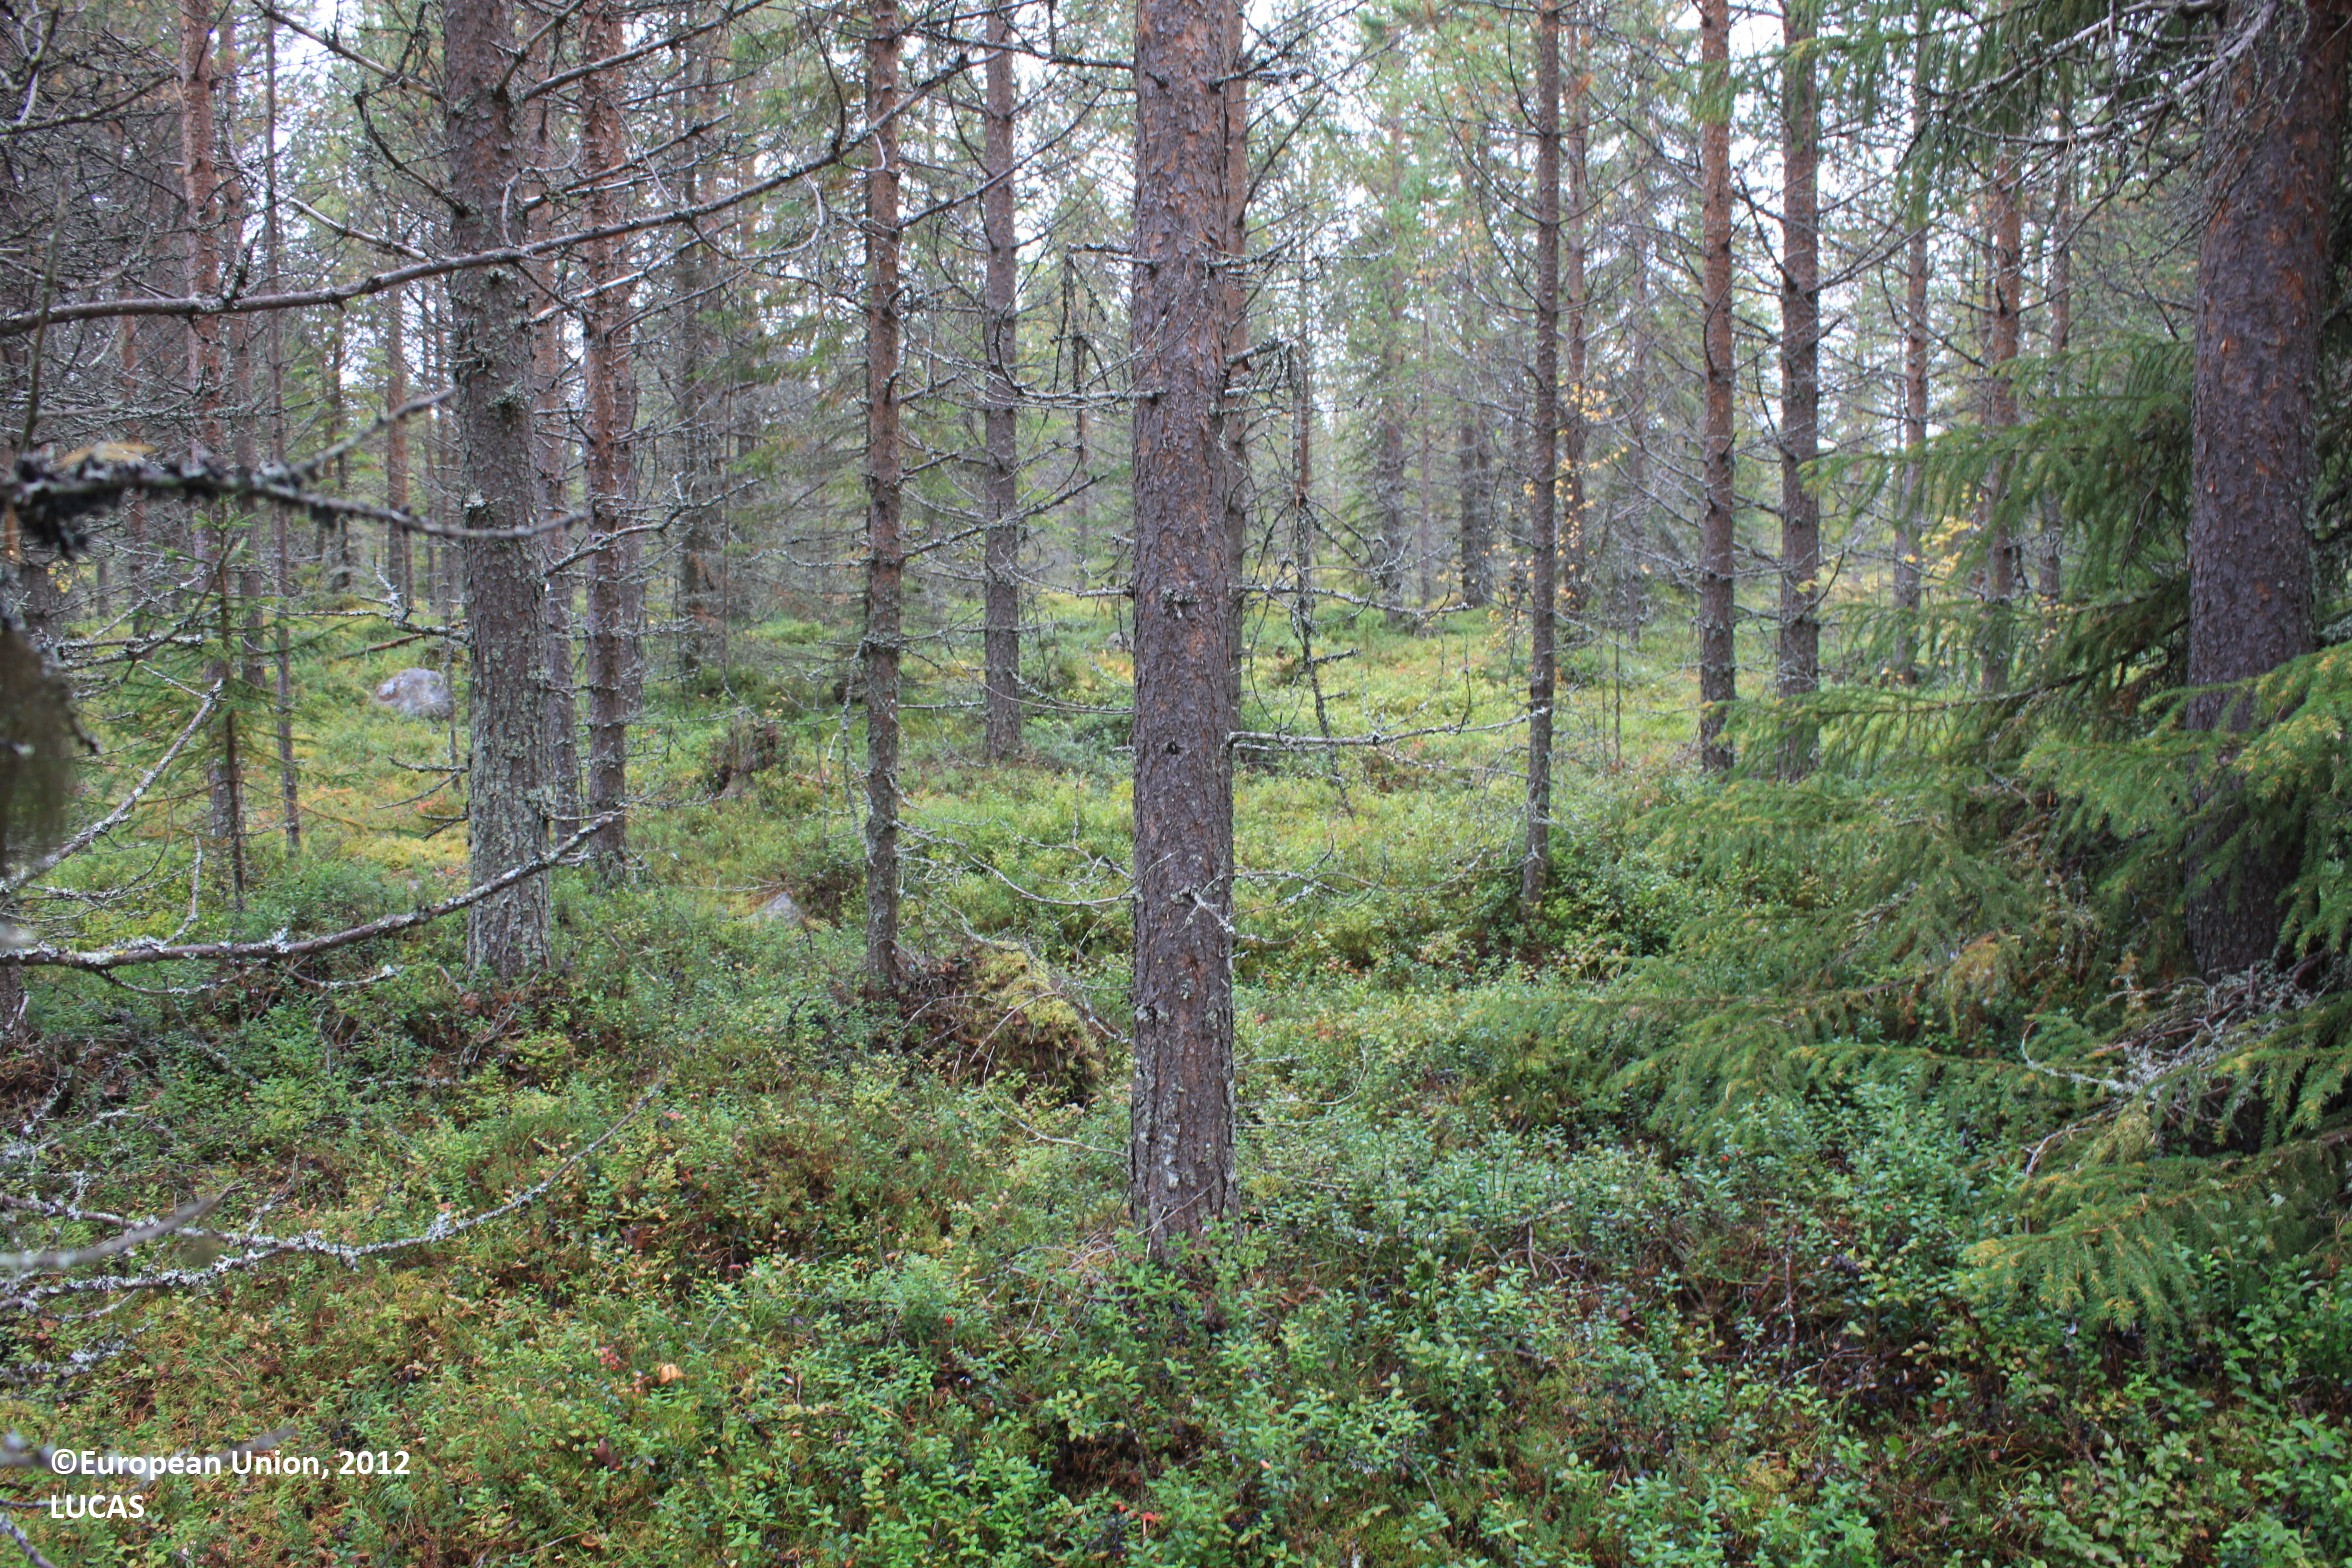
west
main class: Woodland
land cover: Pine dominated coniferous woodland
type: boreal forest
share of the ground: 25 - 50 %
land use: Forestry
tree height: > 5 m
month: September
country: FI
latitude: 65.8892
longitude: 27.3404
